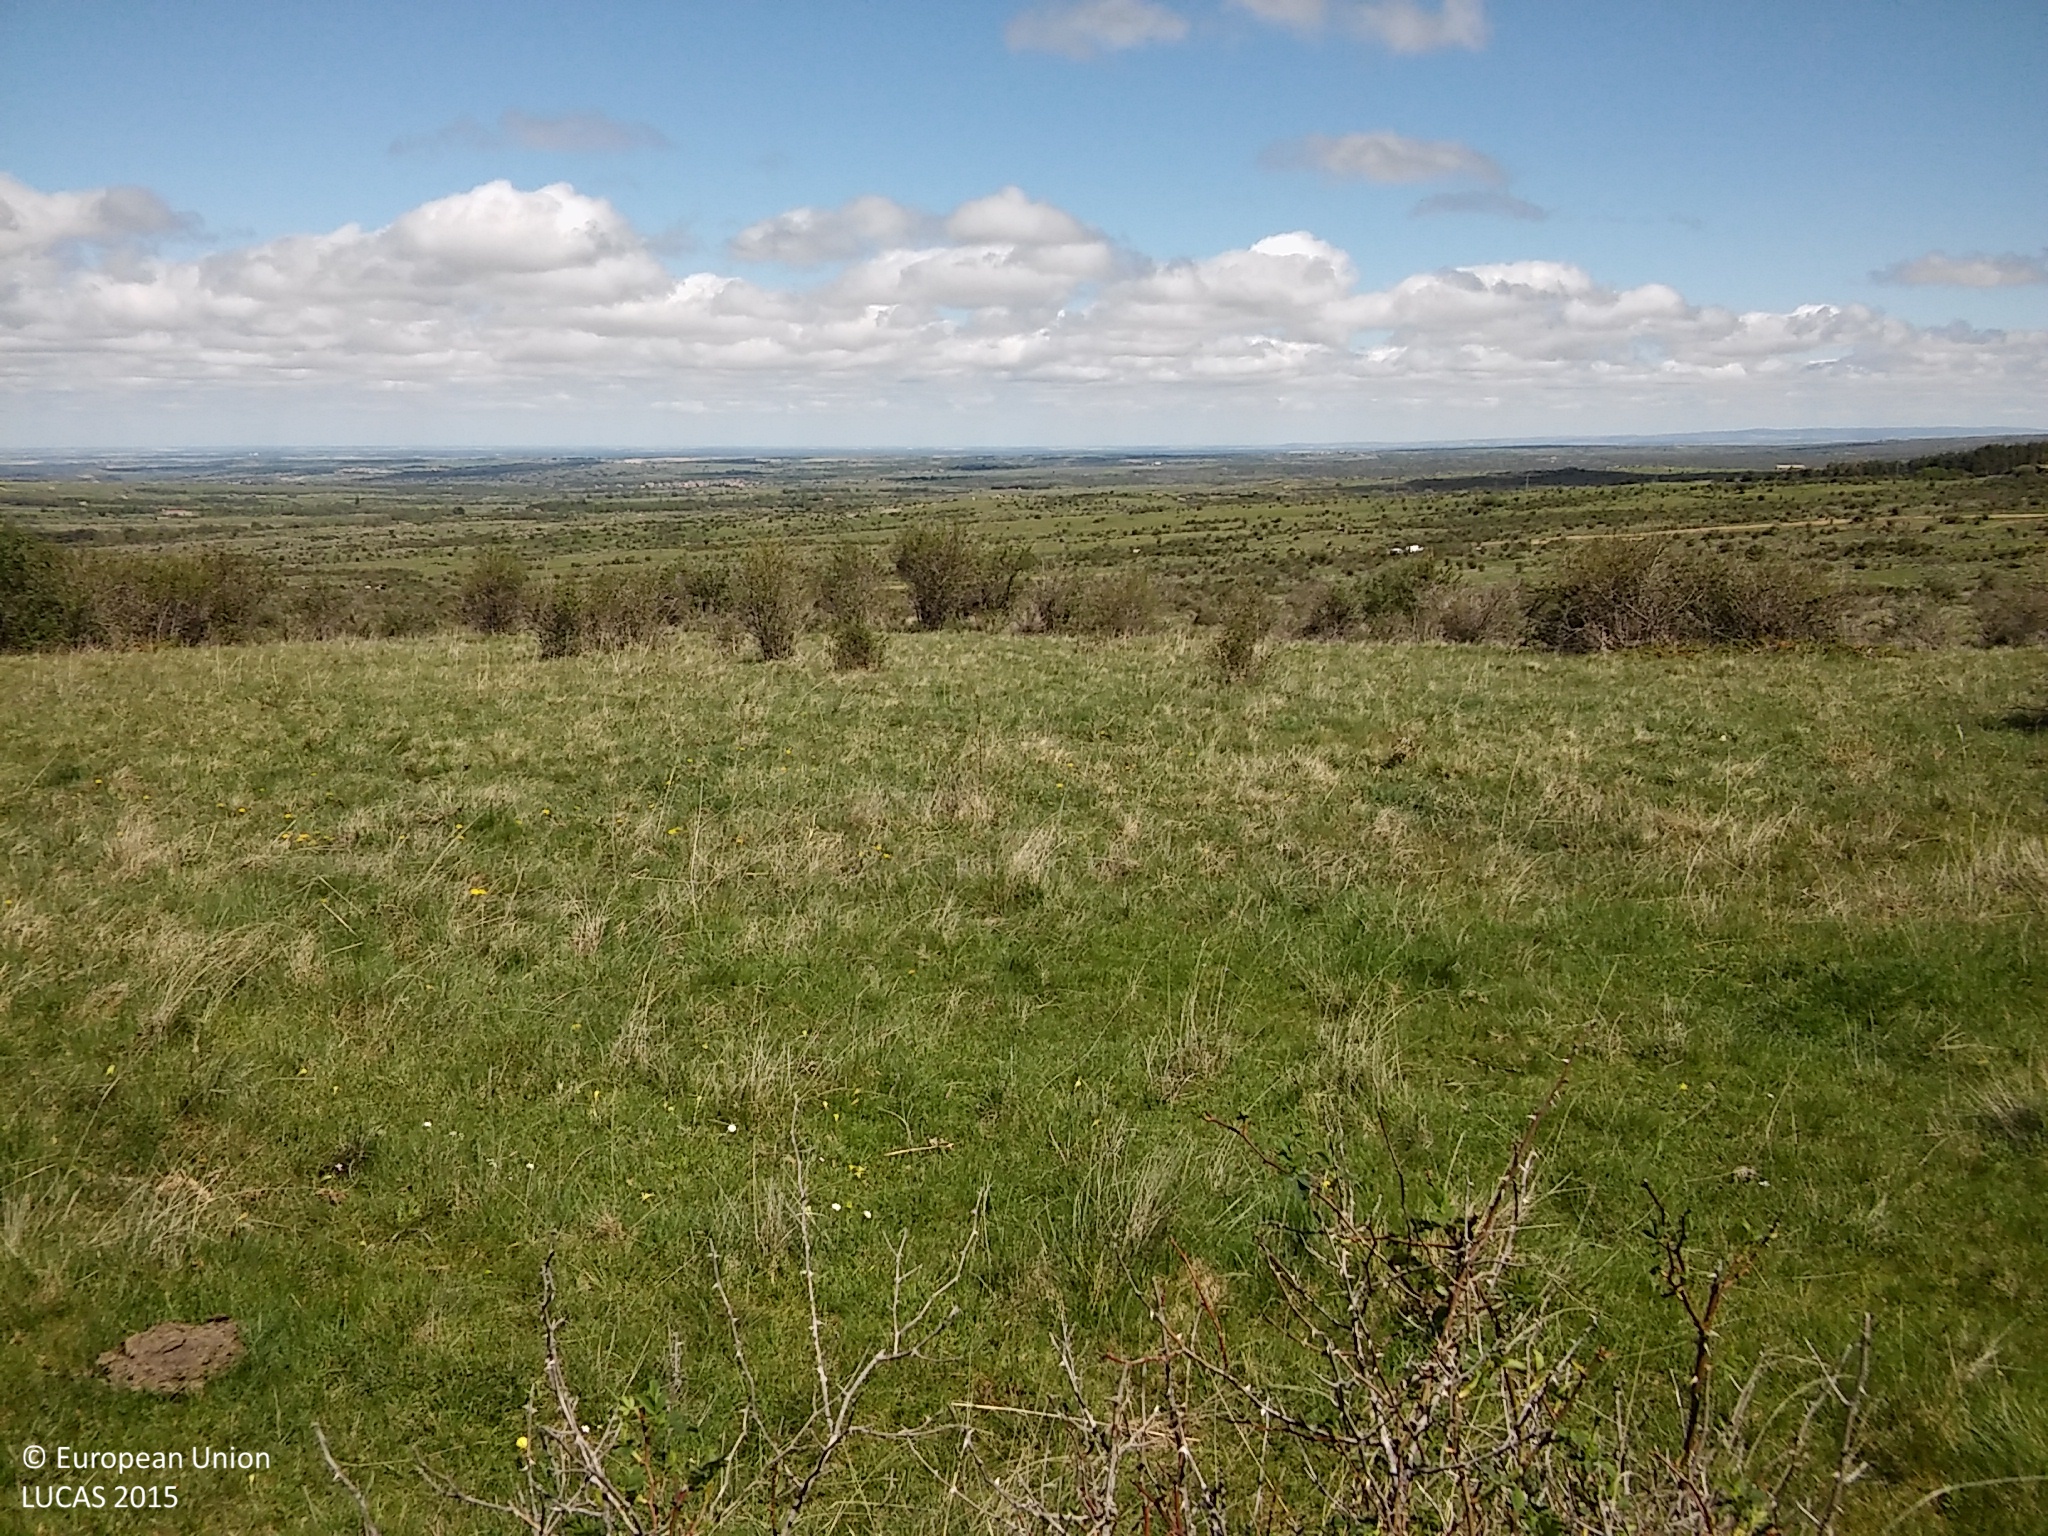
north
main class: Shrubland
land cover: Shrubland without tree cover
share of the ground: 10 - 25 %
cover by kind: herbaceous plants 60 %, shrubs 40 %
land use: Agriculture (excluding fallow land and kitchen gardens)
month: May
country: ES
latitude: 40.9853
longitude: -3.9668
